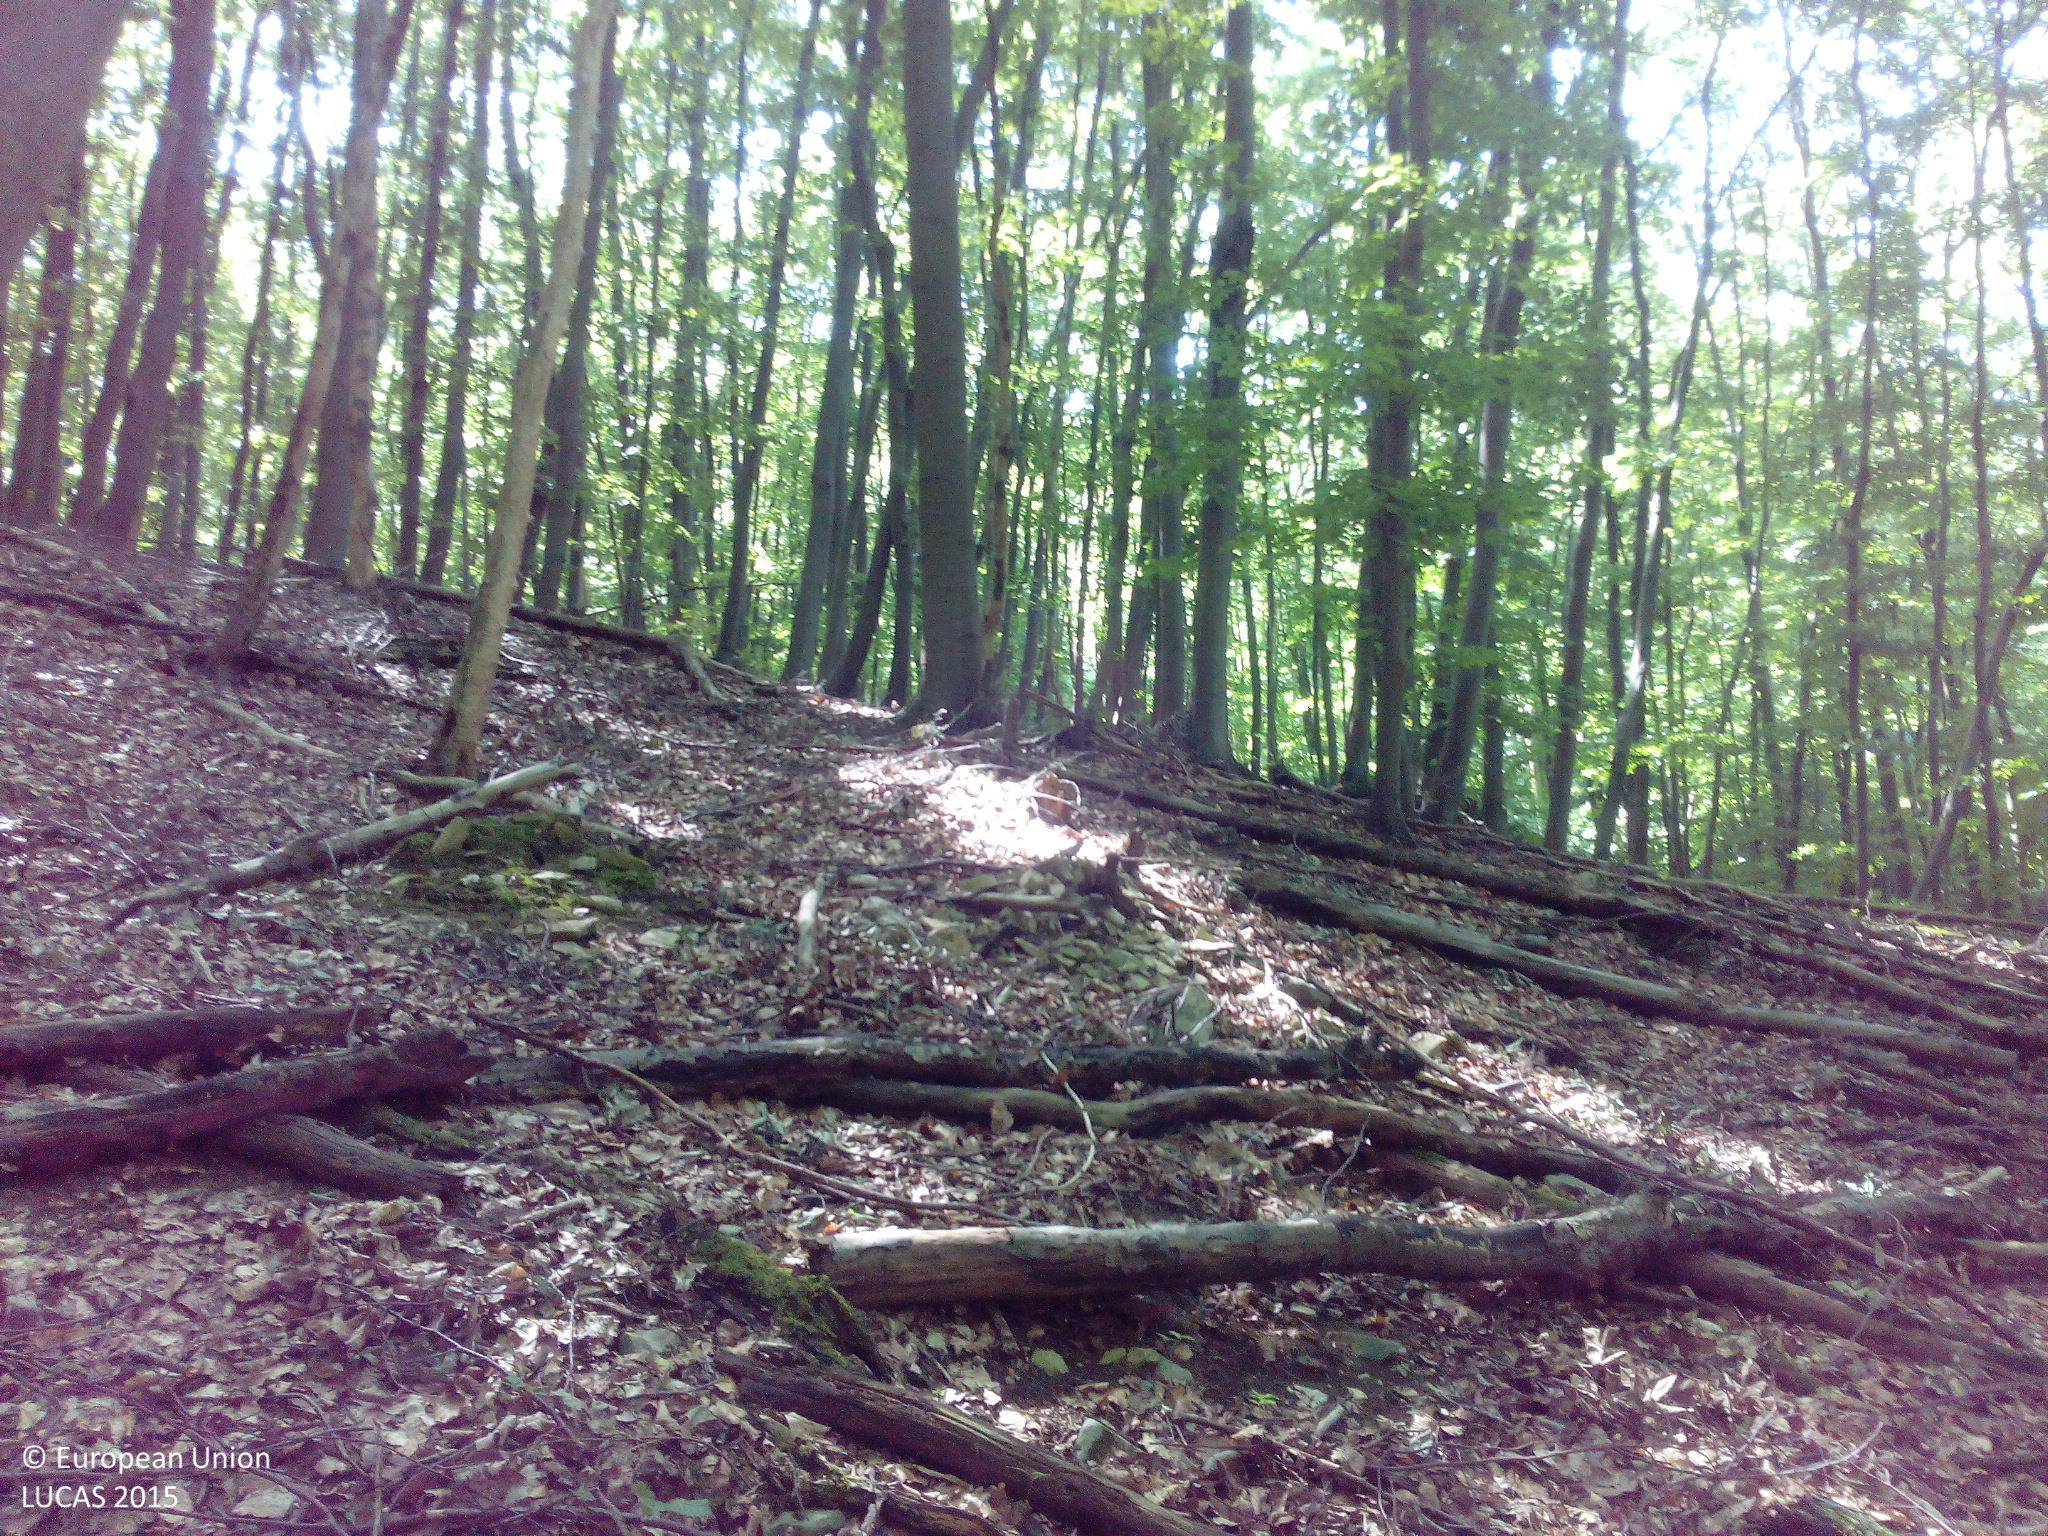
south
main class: Woodland
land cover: Broadleaved woodland
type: beech forest
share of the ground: > 75 %
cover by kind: broadleaved forest trees 100 %
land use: Forestry
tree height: > 5 m
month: August
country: DE
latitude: 51.6387
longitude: 9.3500
